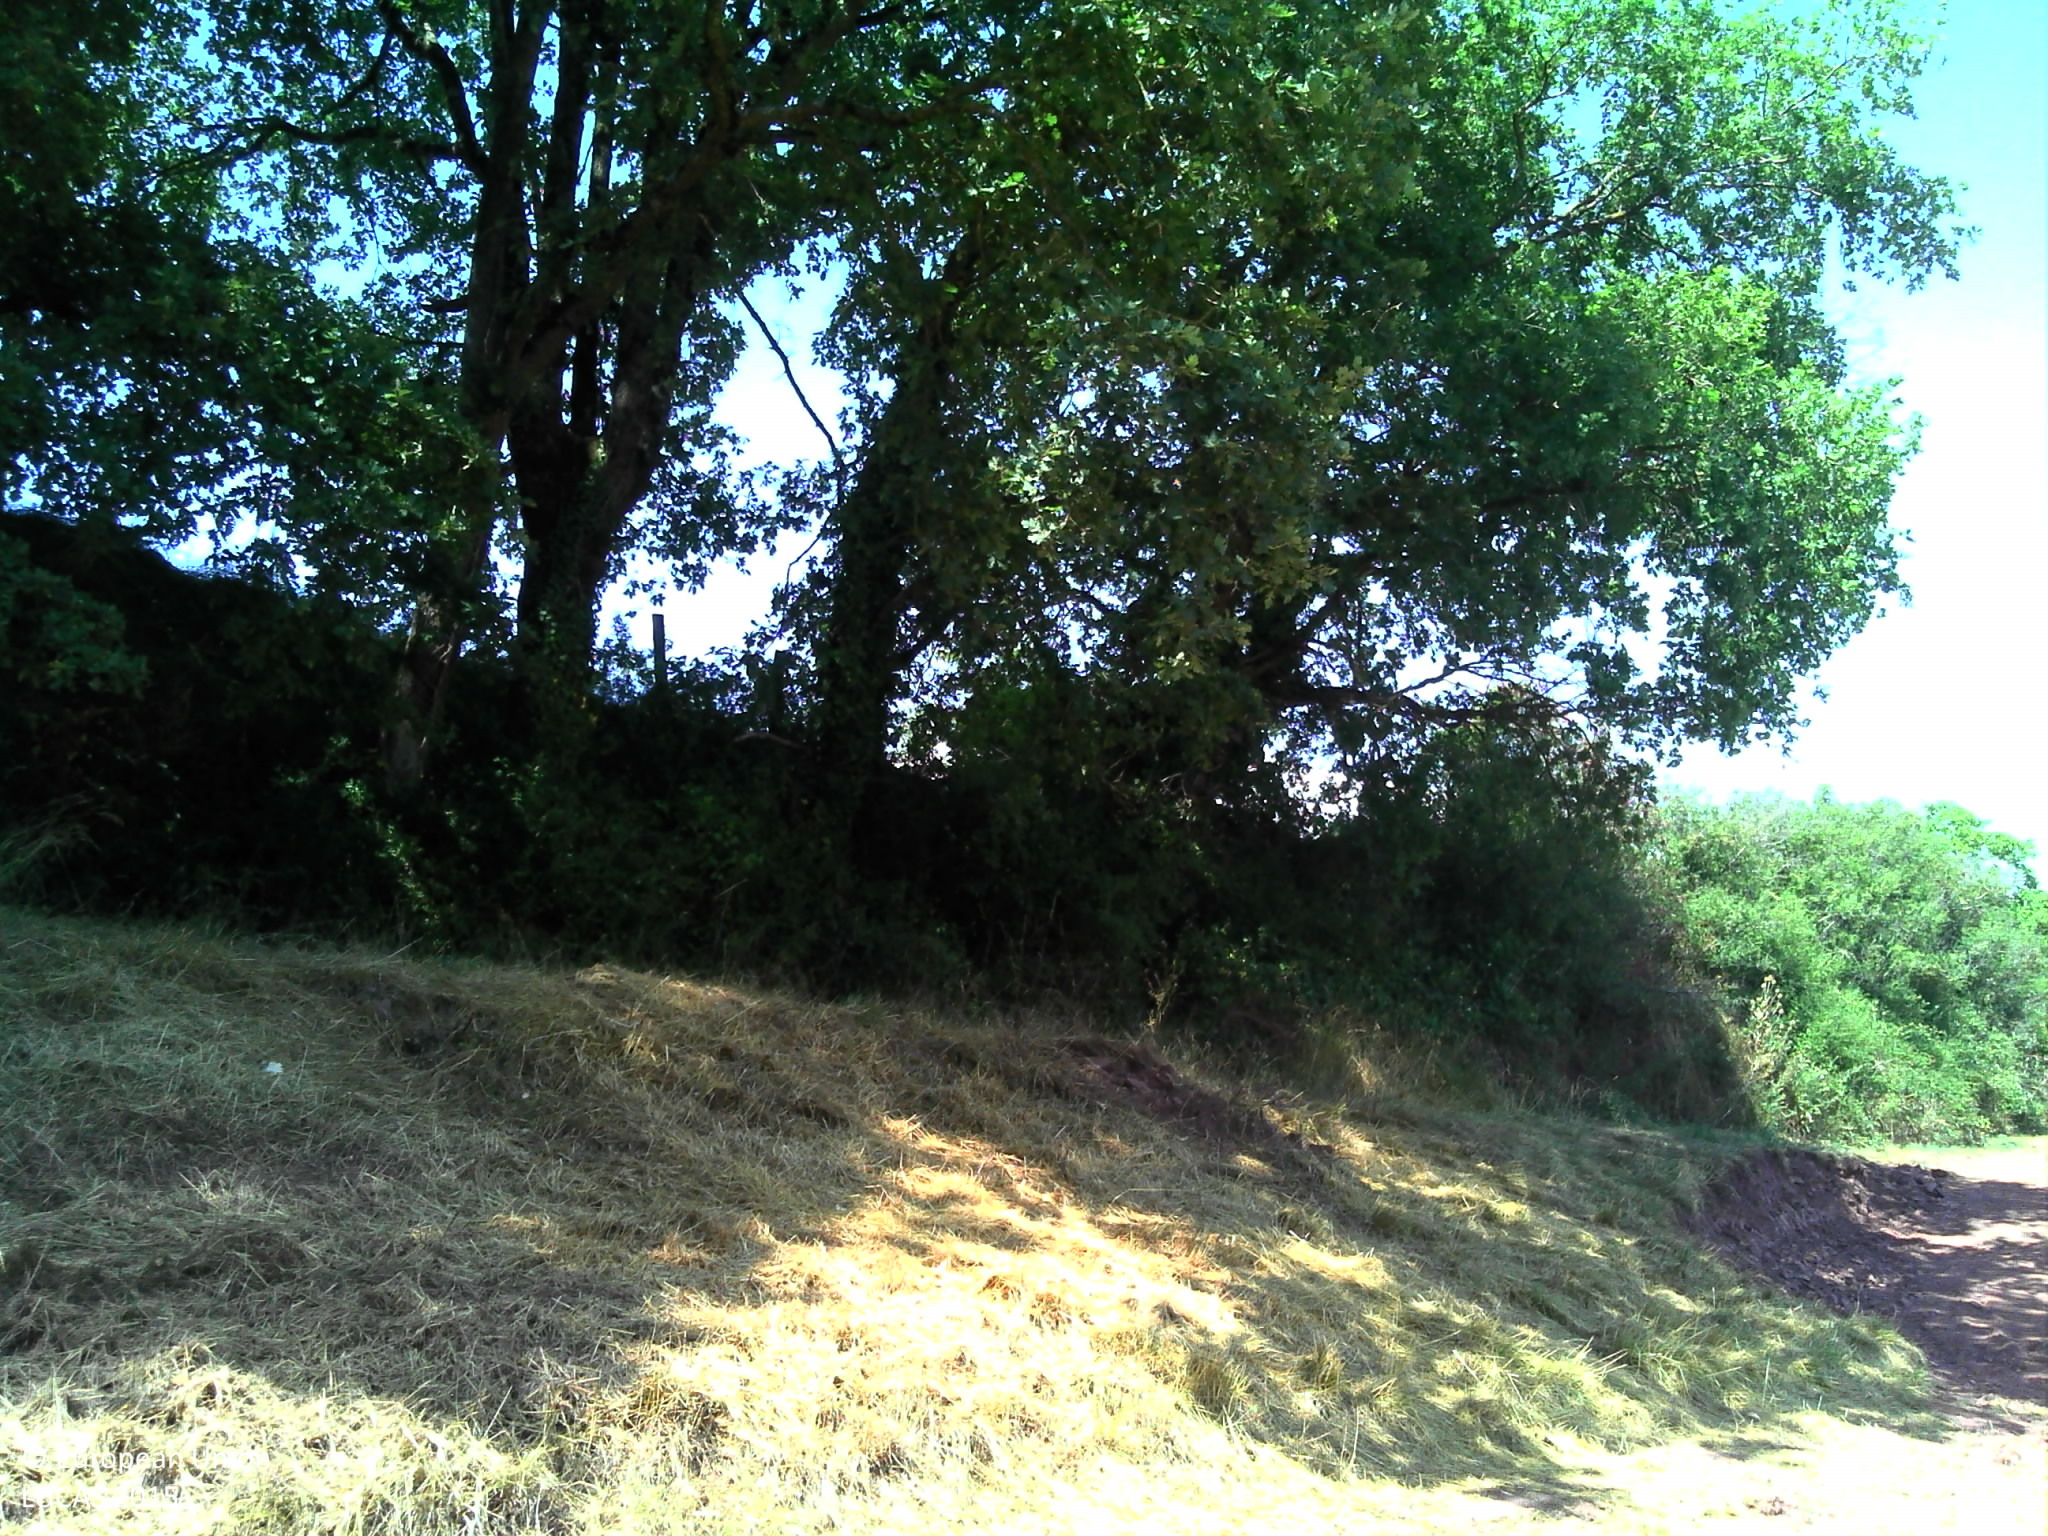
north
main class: Cropland
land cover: Barley
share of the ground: 25 - 50 %
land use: Agriculture (excluding fallow land and kitchen gardens)
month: August
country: FR
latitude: 43.8169
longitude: 2.6334
